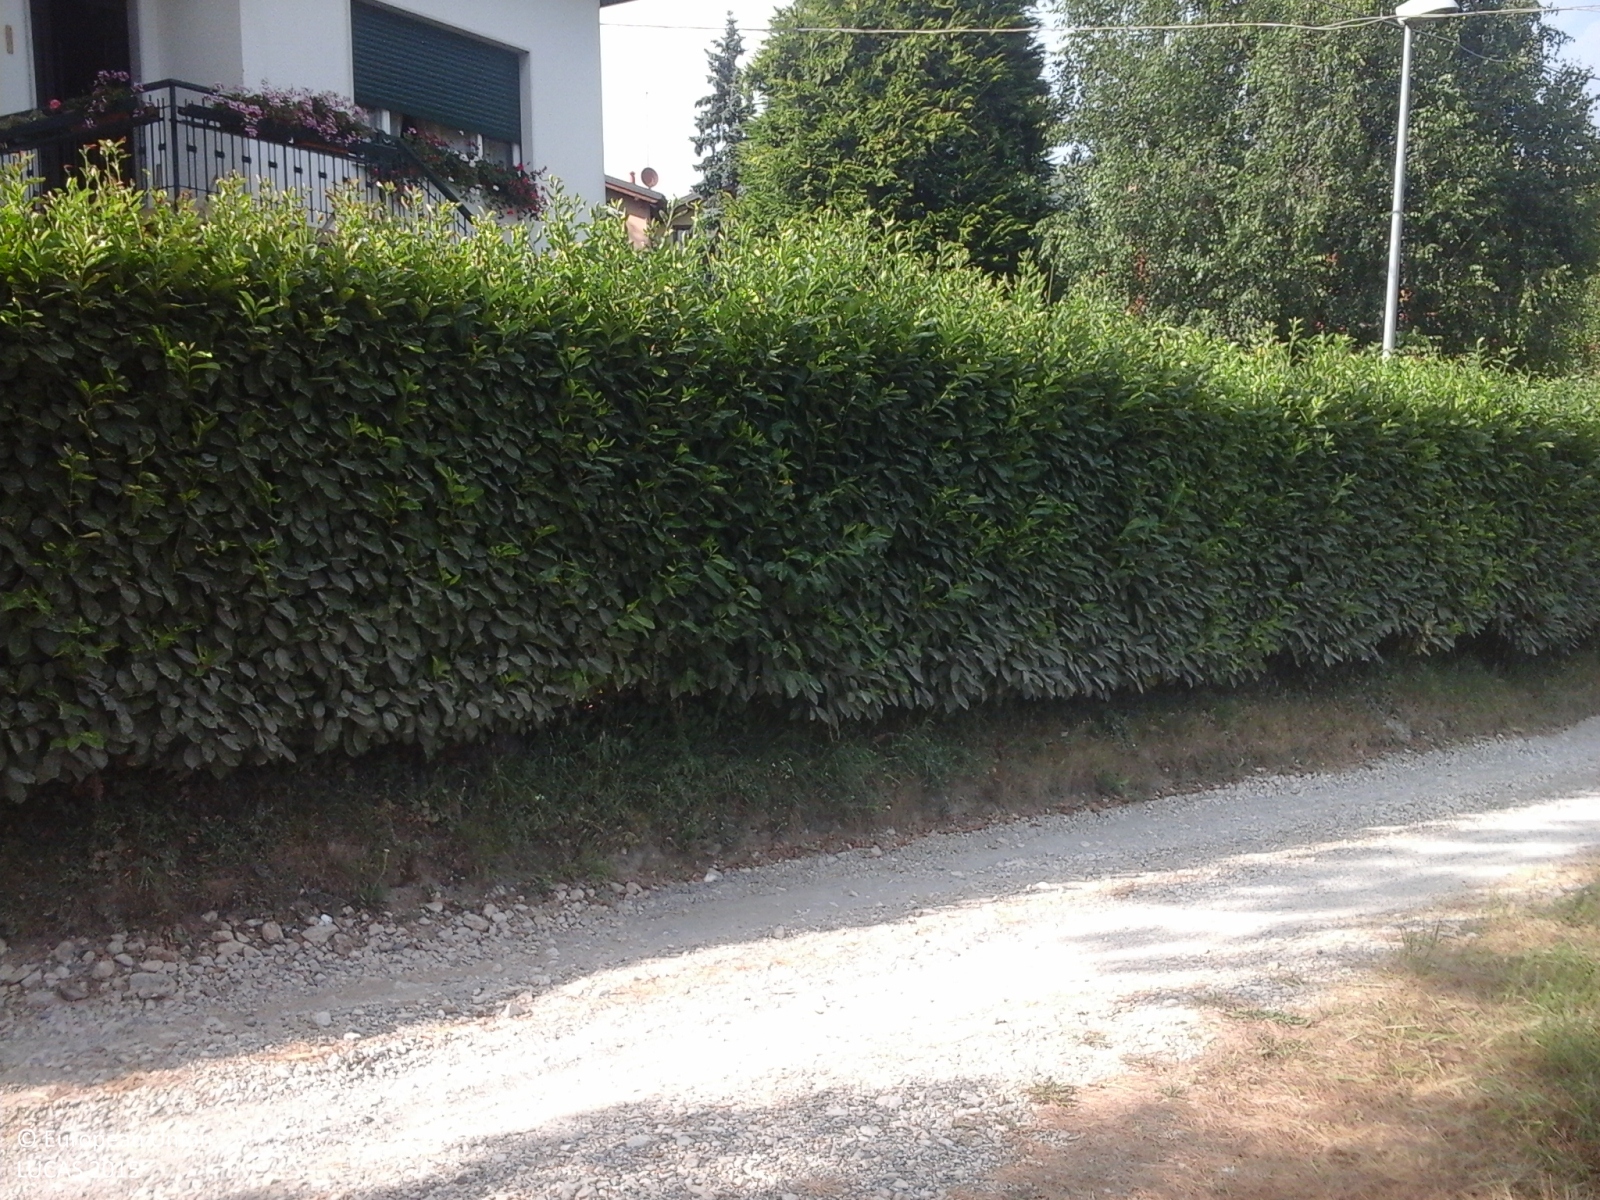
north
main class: Grassland
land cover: Grassland without tree/shrub cover
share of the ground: > 75 %
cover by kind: herbaceous plants 100 %
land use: Agriculture (excluding fallow land and kitchen gardens)
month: July
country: IT
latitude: 45.8581
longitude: 8.8040
